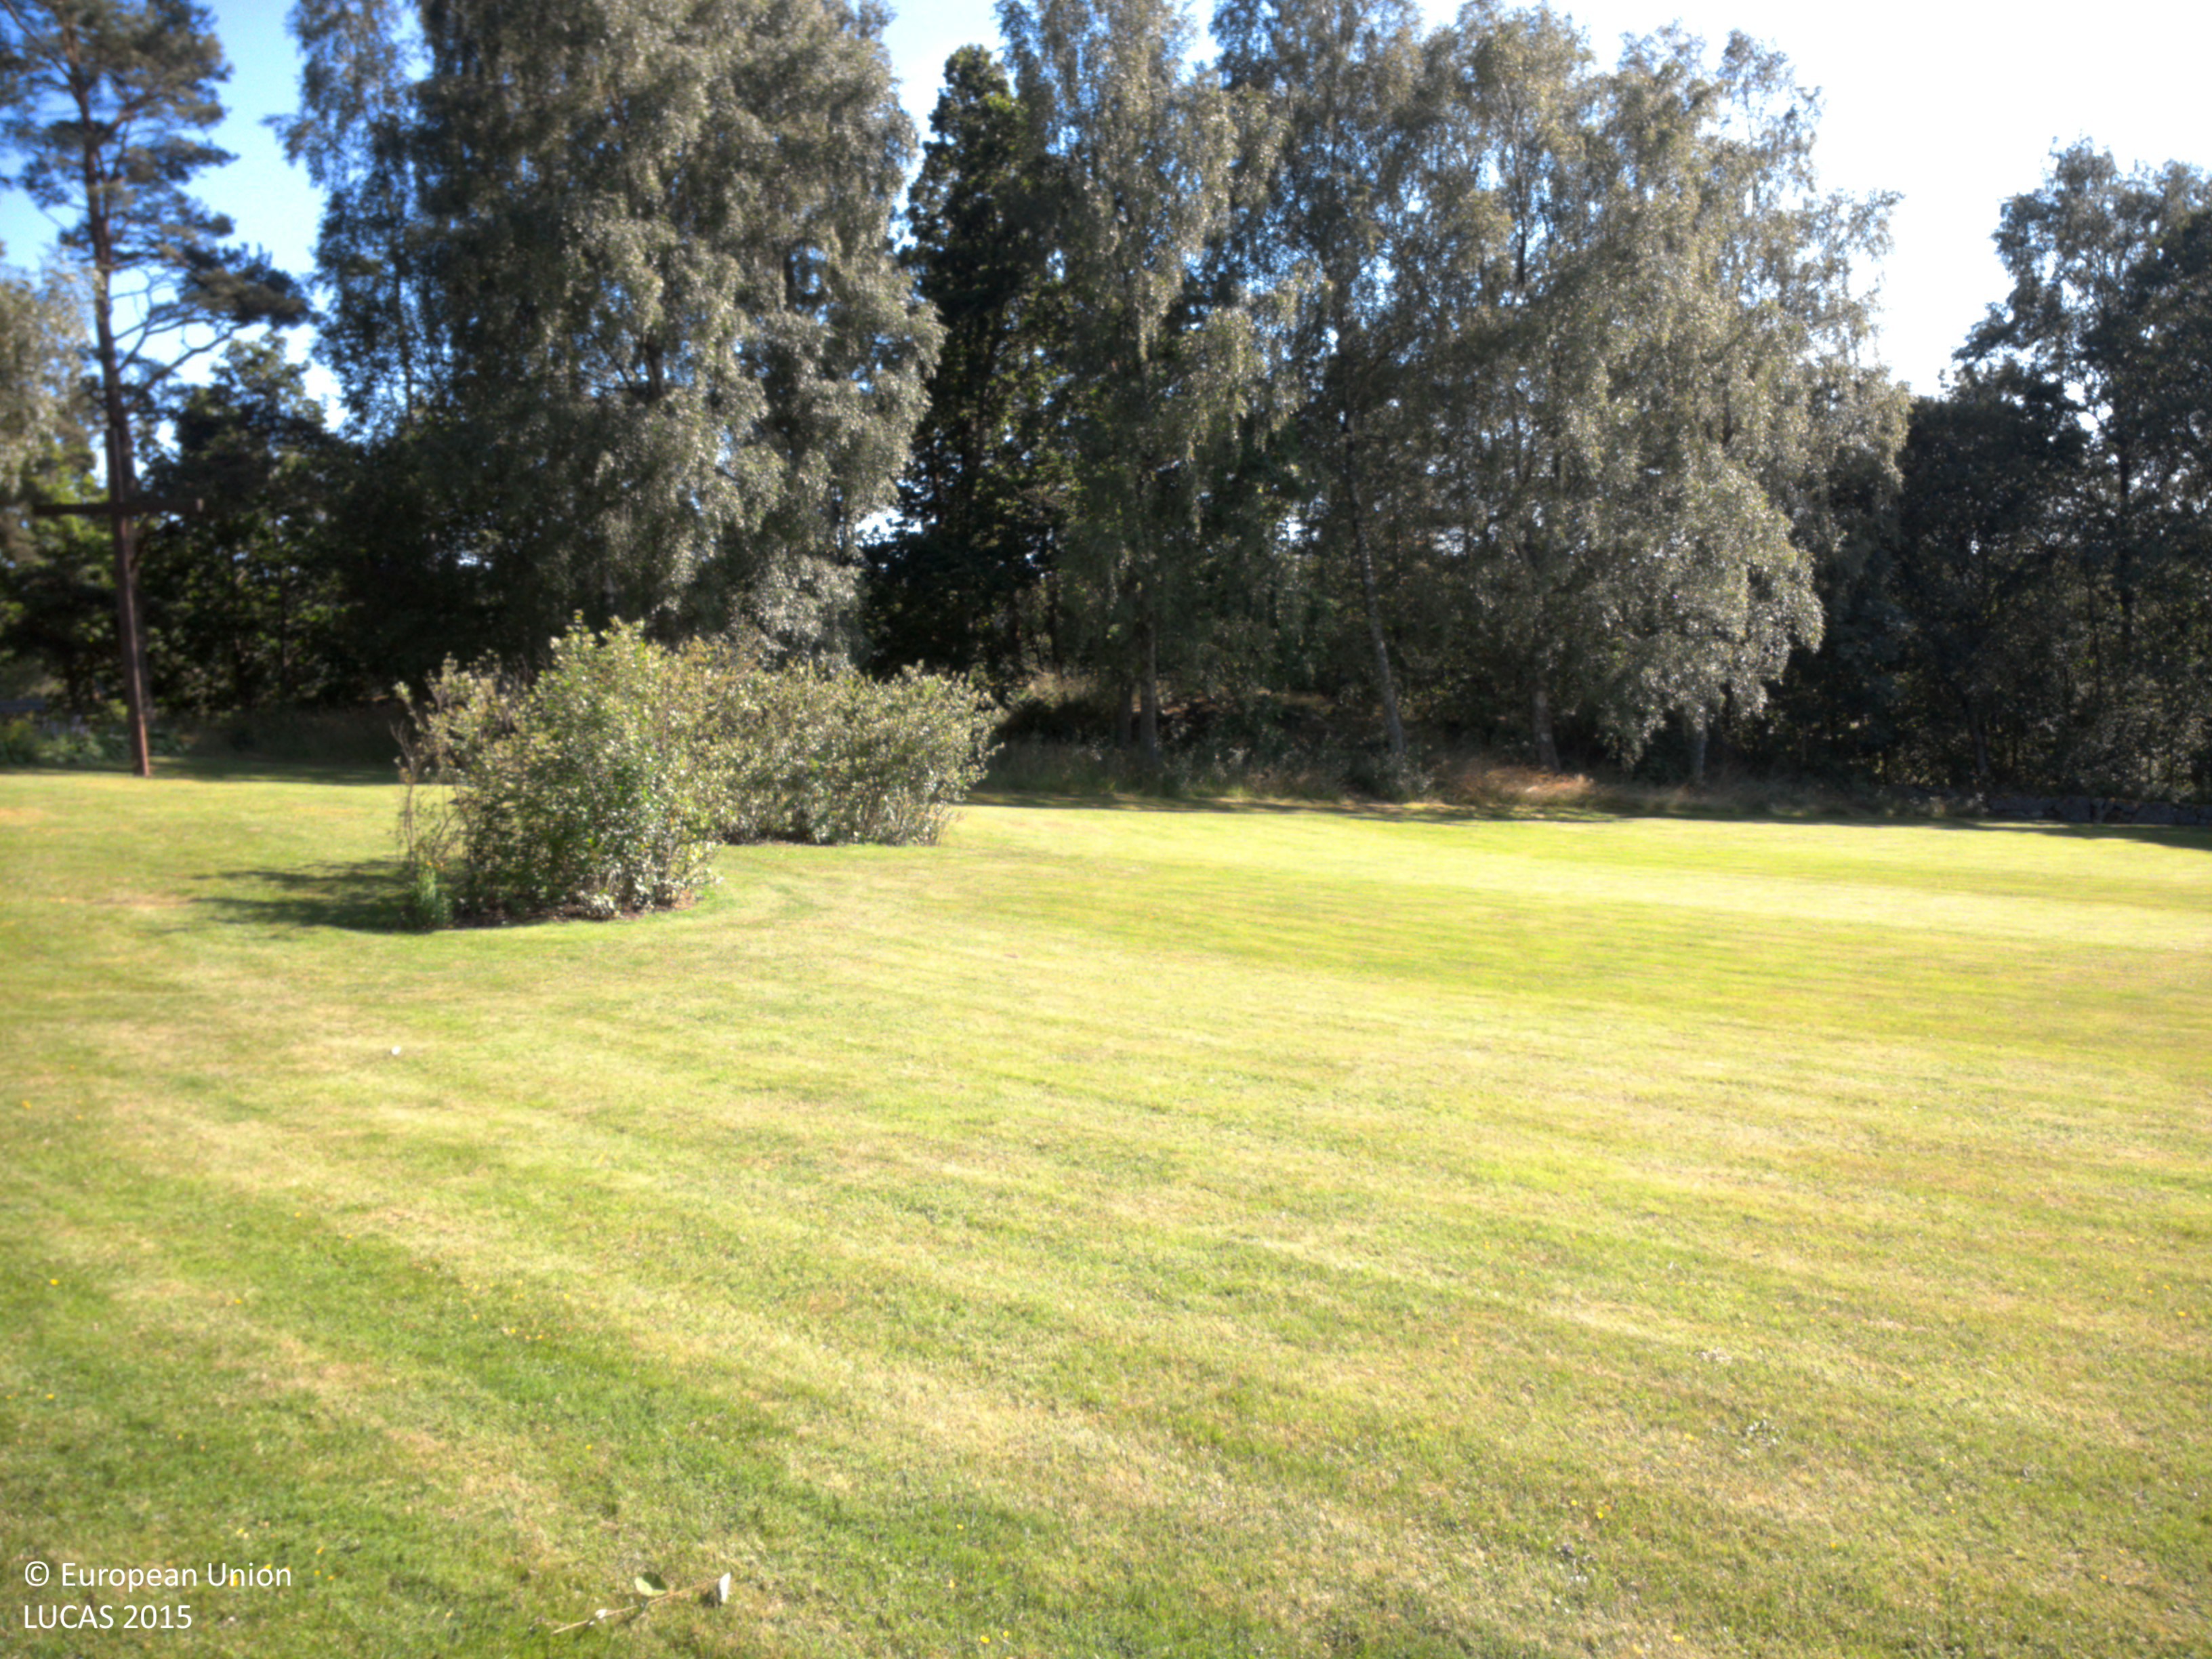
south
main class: Grassland
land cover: Grassland without tree/shrub cover
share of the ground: > 75 %
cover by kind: herbaceous plants 100 %
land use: Community services
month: July
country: SE
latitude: 57.9854
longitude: 12.2116
